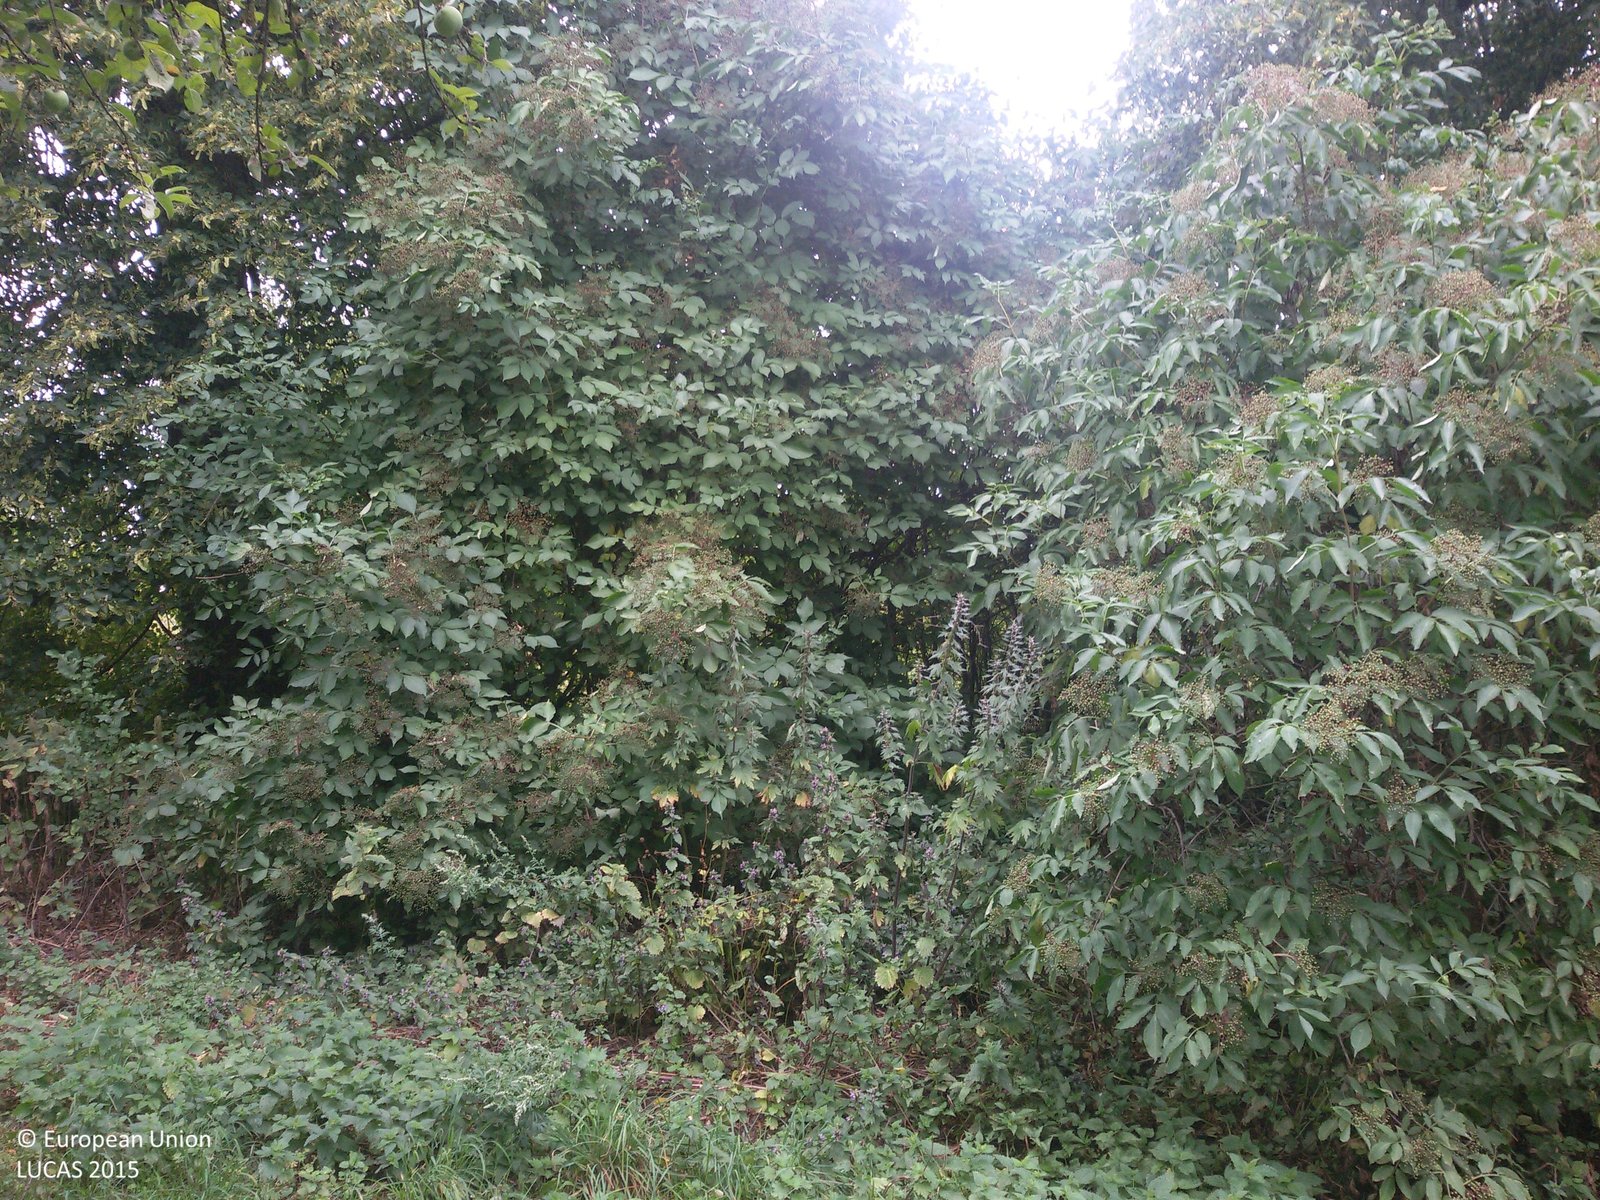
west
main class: Woodland
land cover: Broadleaved woodland
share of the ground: 50 - 75 %
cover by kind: shrubs 65 %, broadleaved forest trees 20 %, herbaceous plants 5 %
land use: Residential
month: July
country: PL
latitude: 53.6732
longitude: 23.5721
